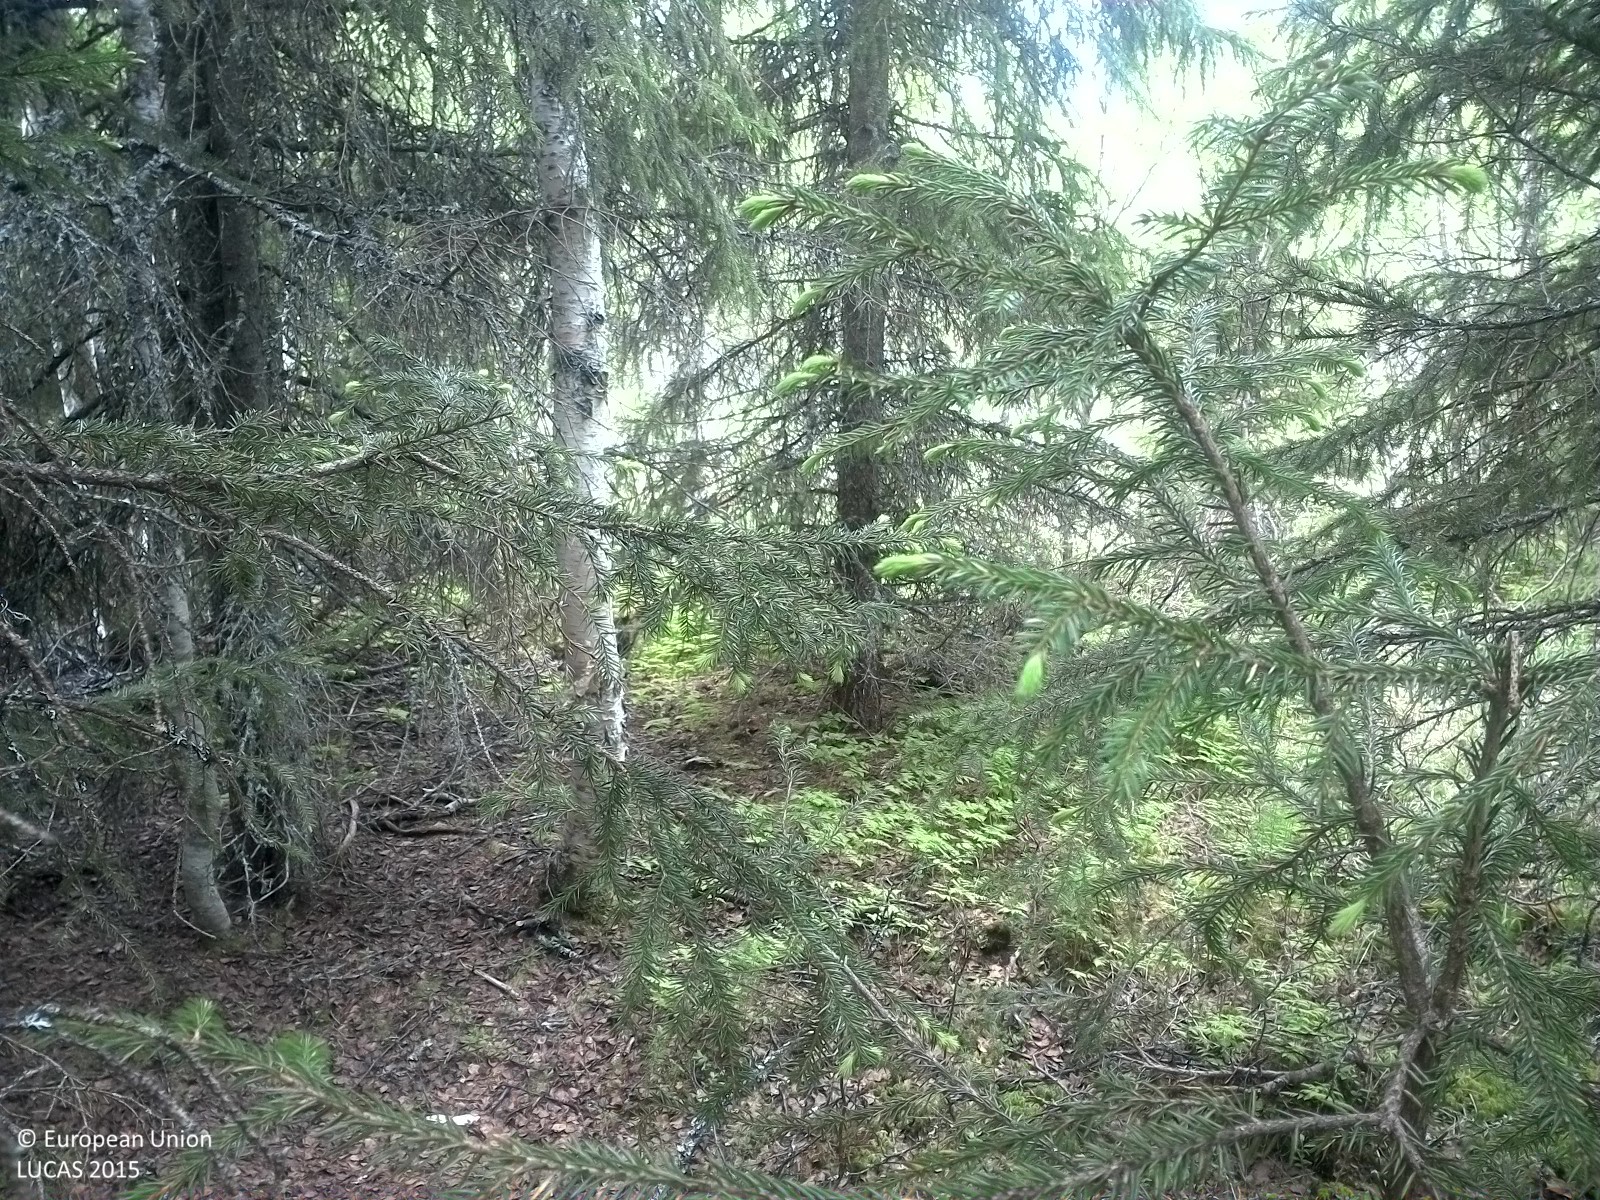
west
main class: Woodland
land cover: Spruce dominated mixed woodland
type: boreal forest
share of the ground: > 75 %
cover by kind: coniferous forest trees 60 %, broadleaved forest trees 25 %, shrubs 15 %
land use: Forestry
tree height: > 5 m
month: June
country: SE
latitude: 63.4675
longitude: 15.0528
